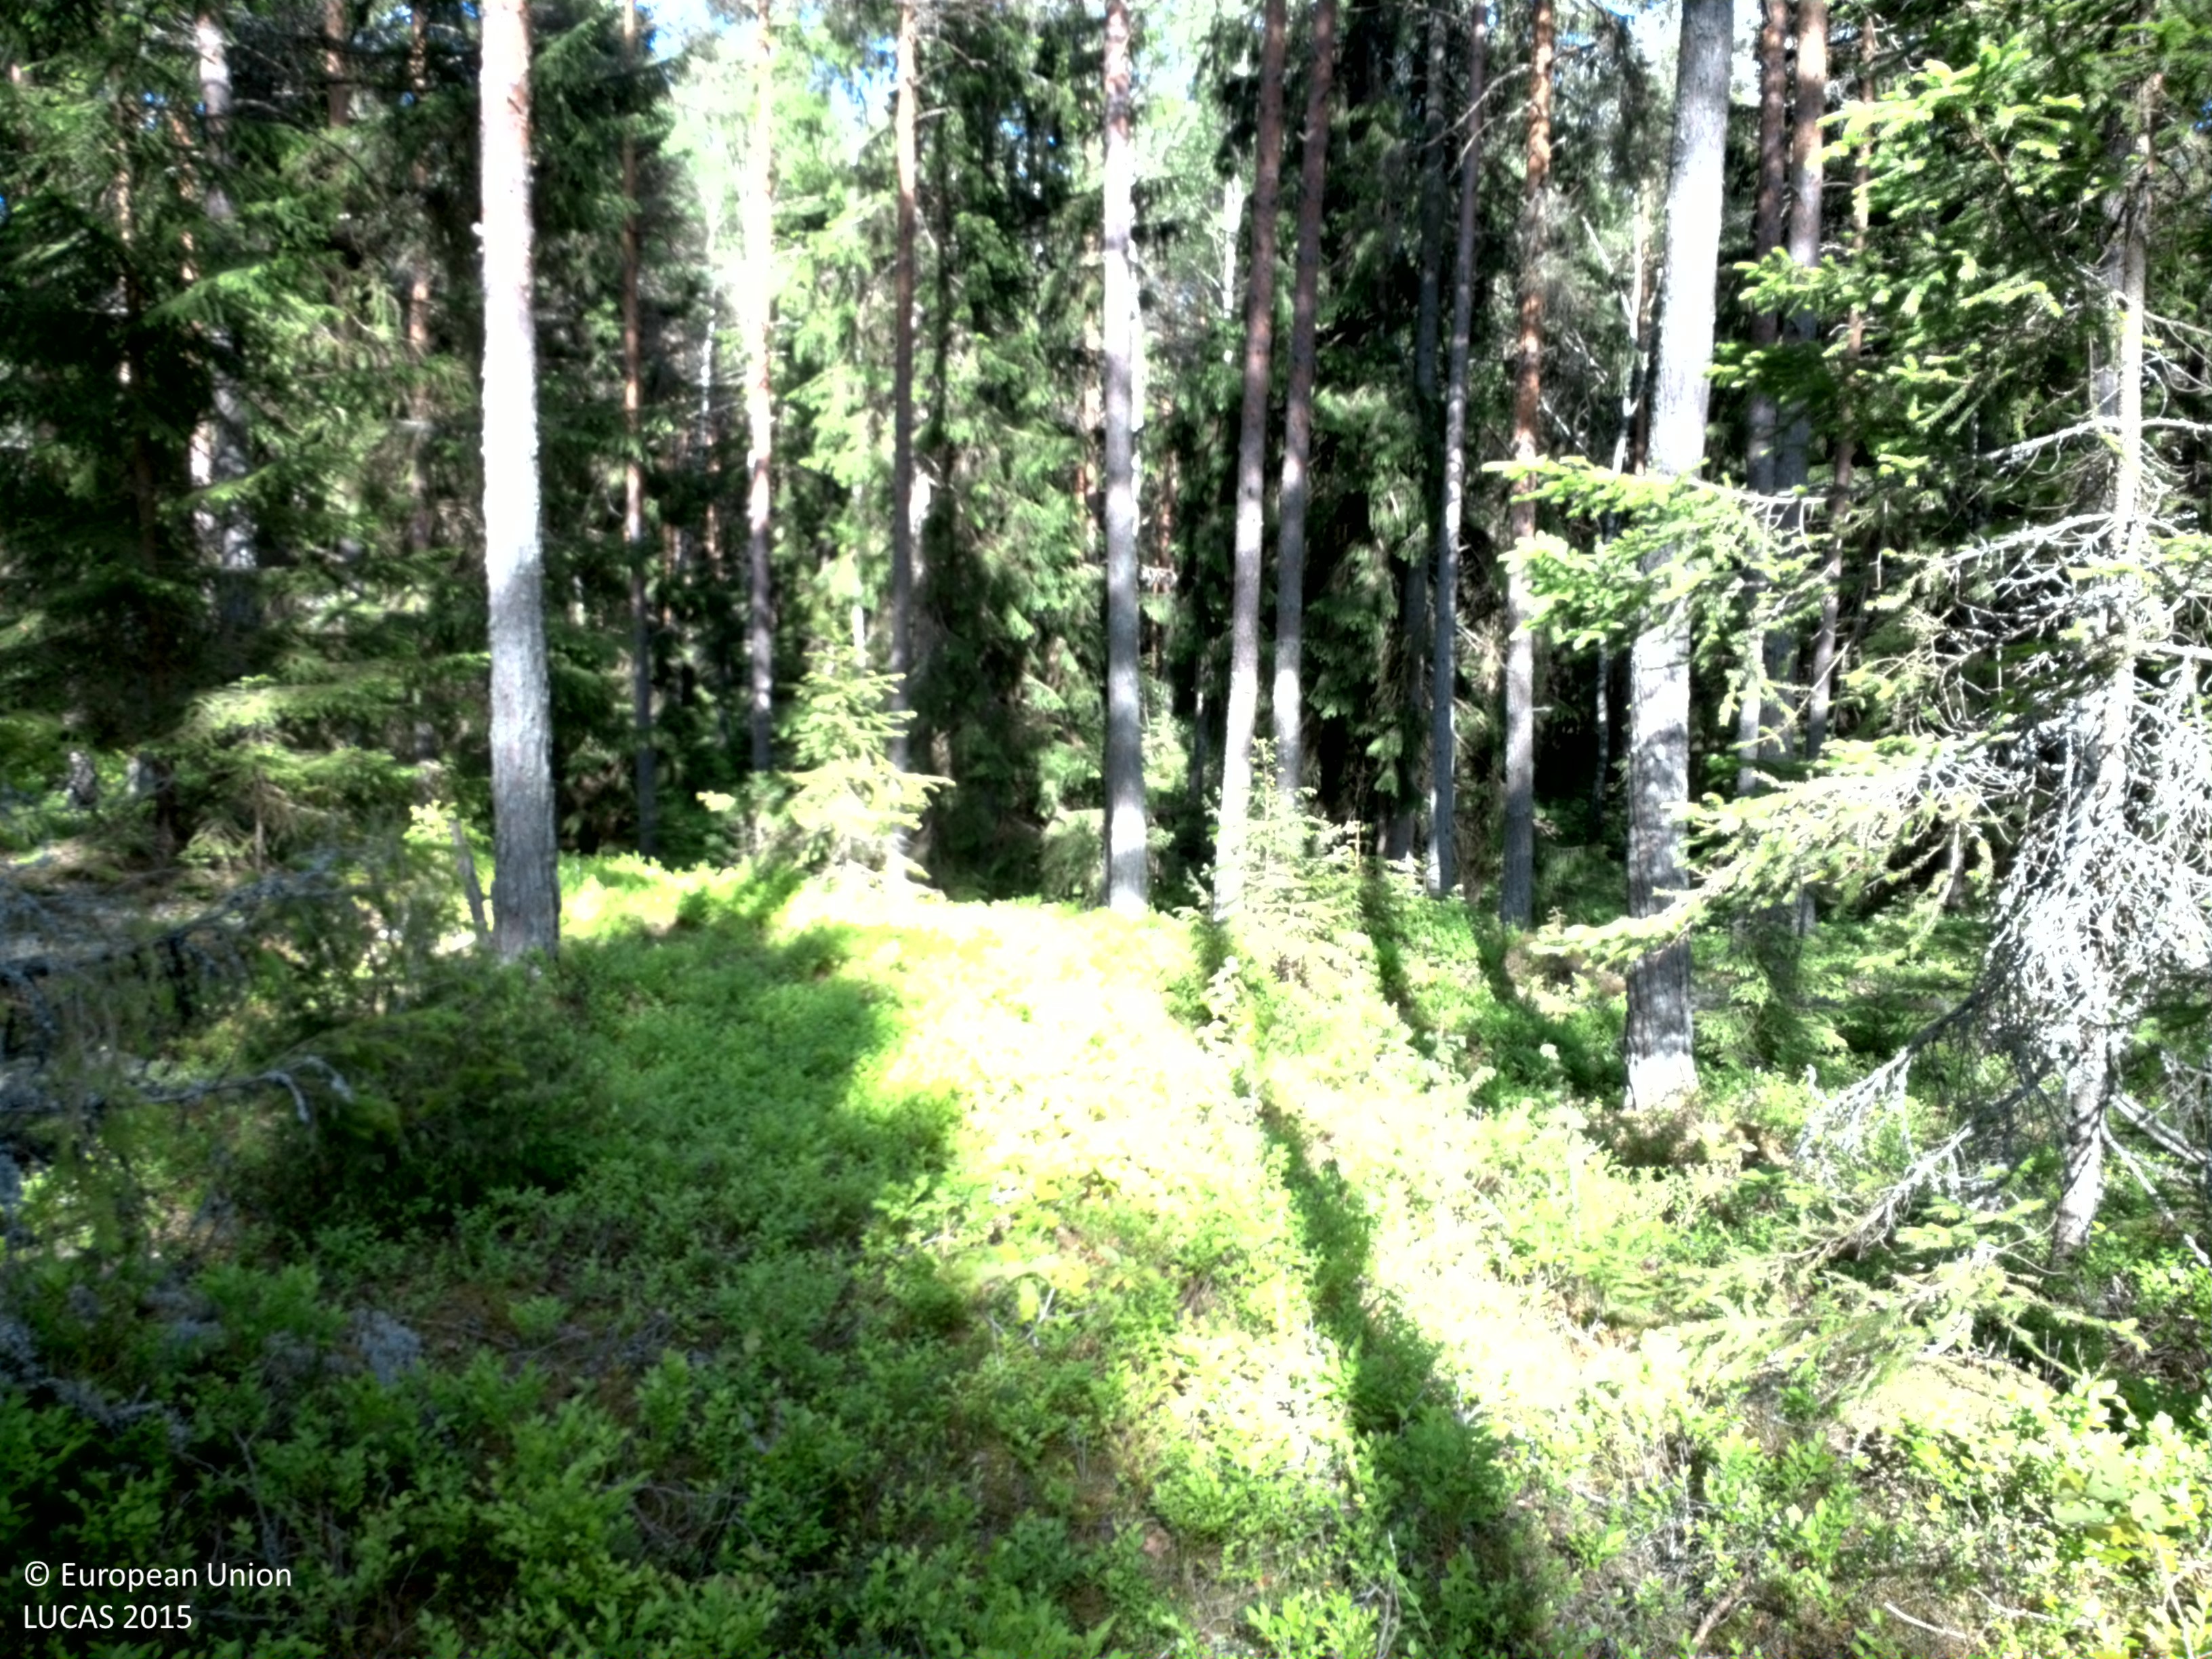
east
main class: Woodland
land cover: Pine dominated coniferous woodland
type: boreal forest
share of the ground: 25 - 50 %
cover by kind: herbaceous plants 45 %, coniferous forest trees 40 %, lichens and mosses 15 %
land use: Forestry
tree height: > 5 m
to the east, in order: Pine dominated coniferous woodland; Spruce dominated coniferous woodland; Pine dominated coniferous woodland
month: June
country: SE
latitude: 58.3963
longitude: 16.3091
